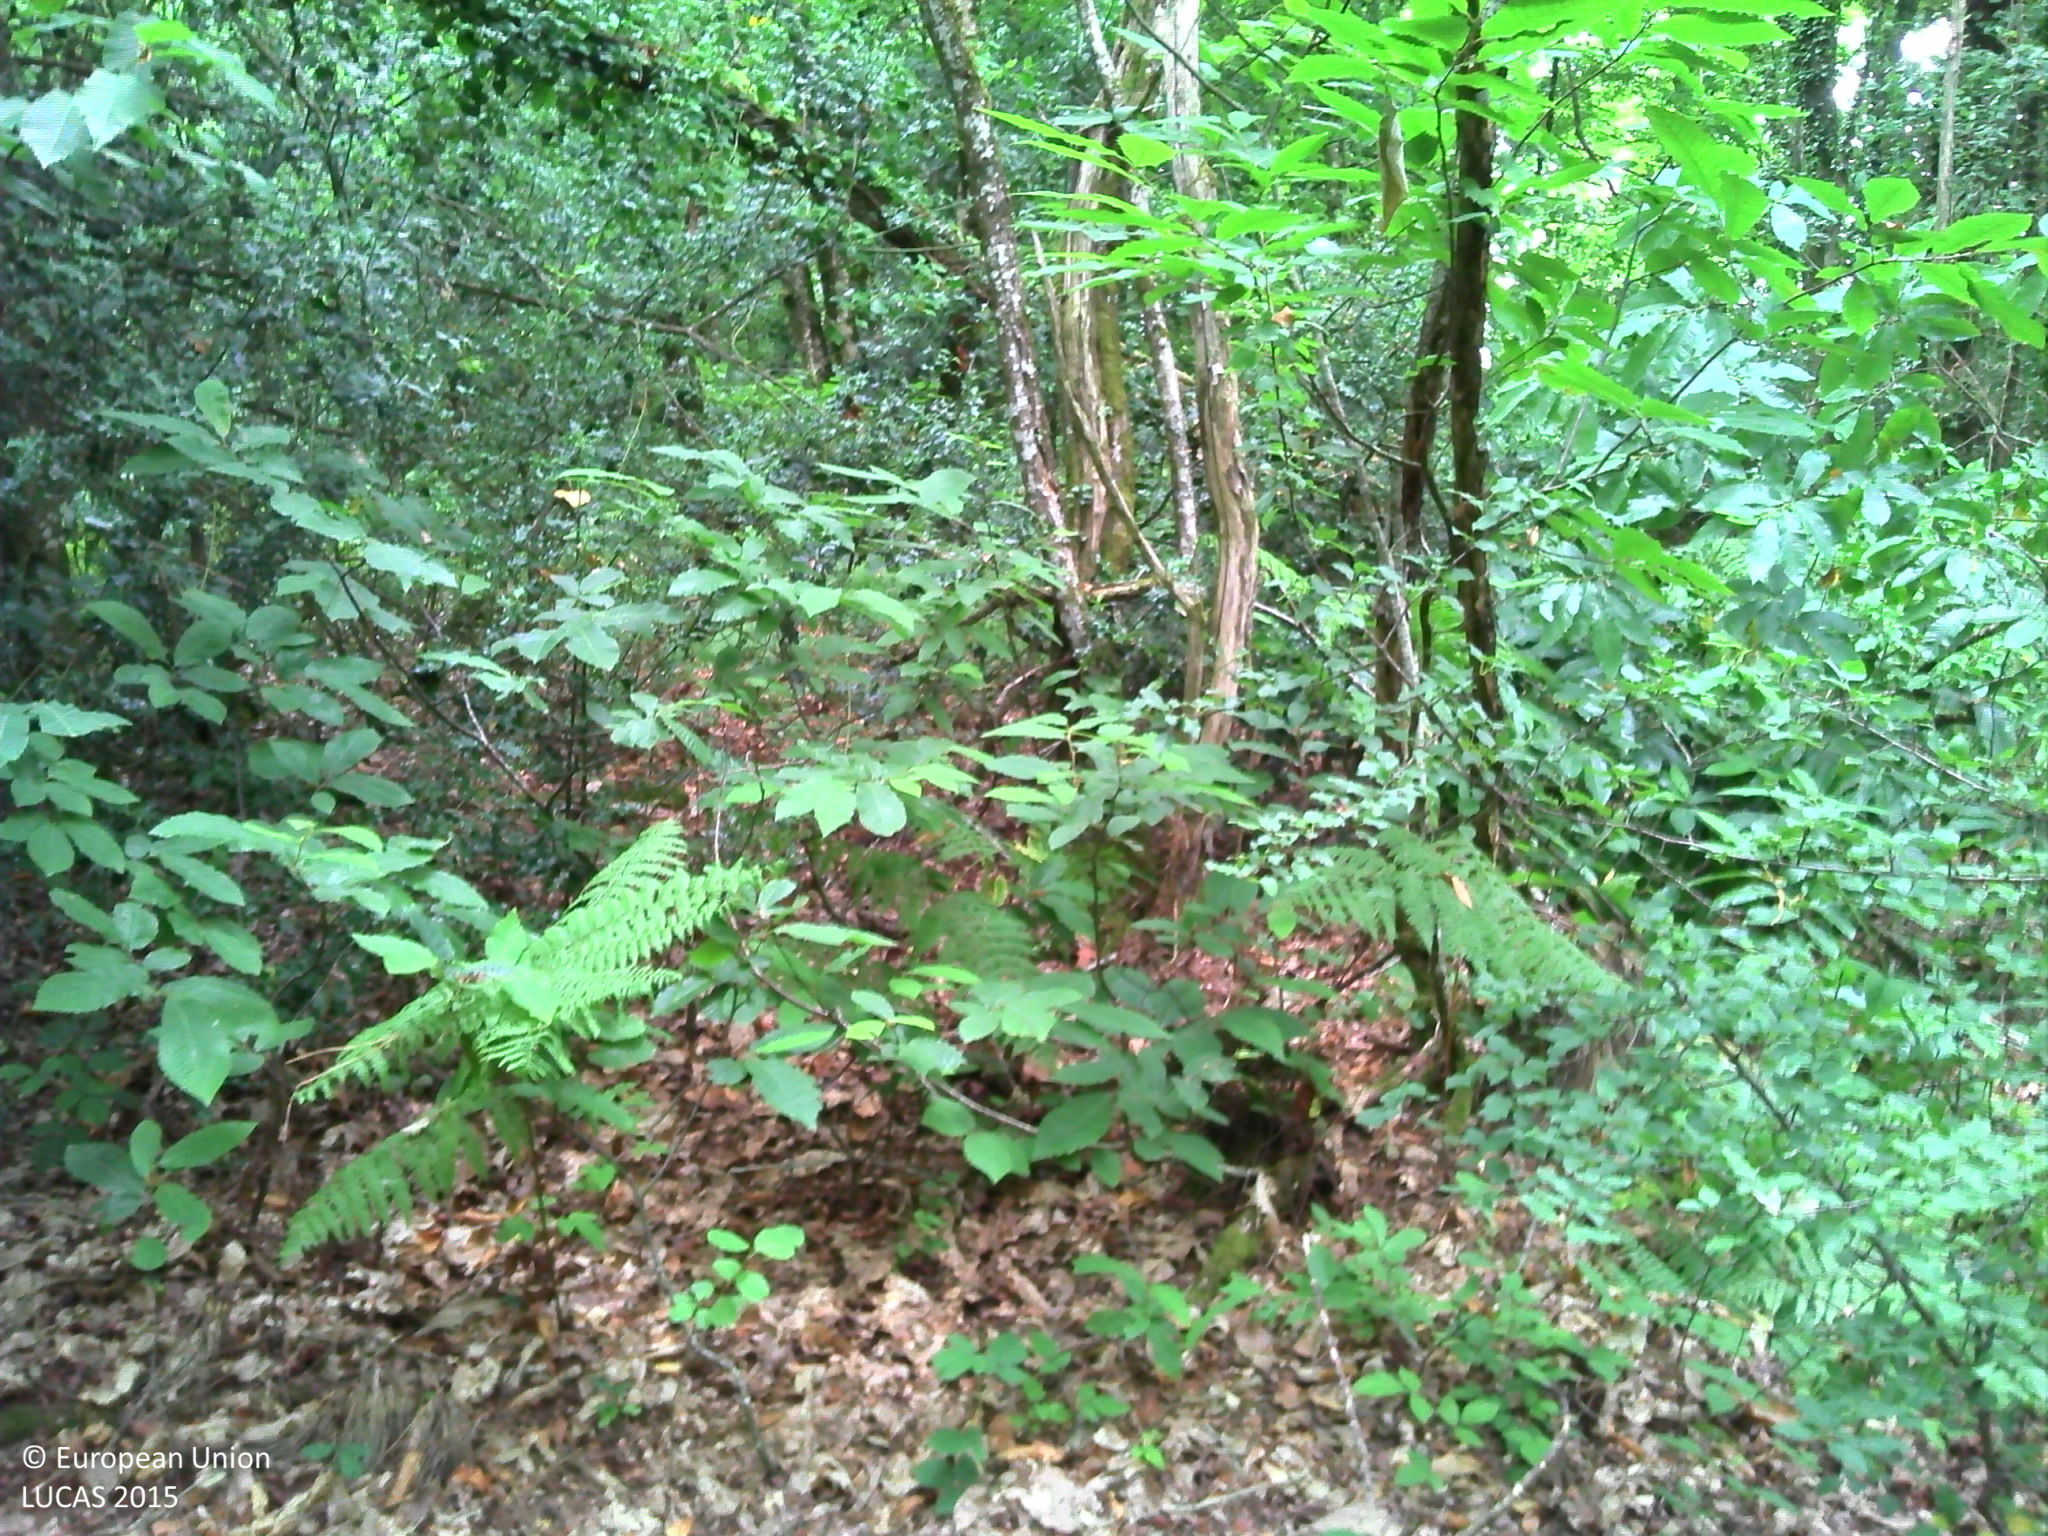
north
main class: Woodland
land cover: Broadleaved woodland
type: thermophilous deciduous forest
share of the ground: > 75 %
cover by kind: broadleaved forest trees 80 %, herbaceous plants 15 %, shrubs 5 %
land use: Forestry
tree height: > 5 m
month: July
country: FR
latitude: 47.8522
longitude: -3.2896
